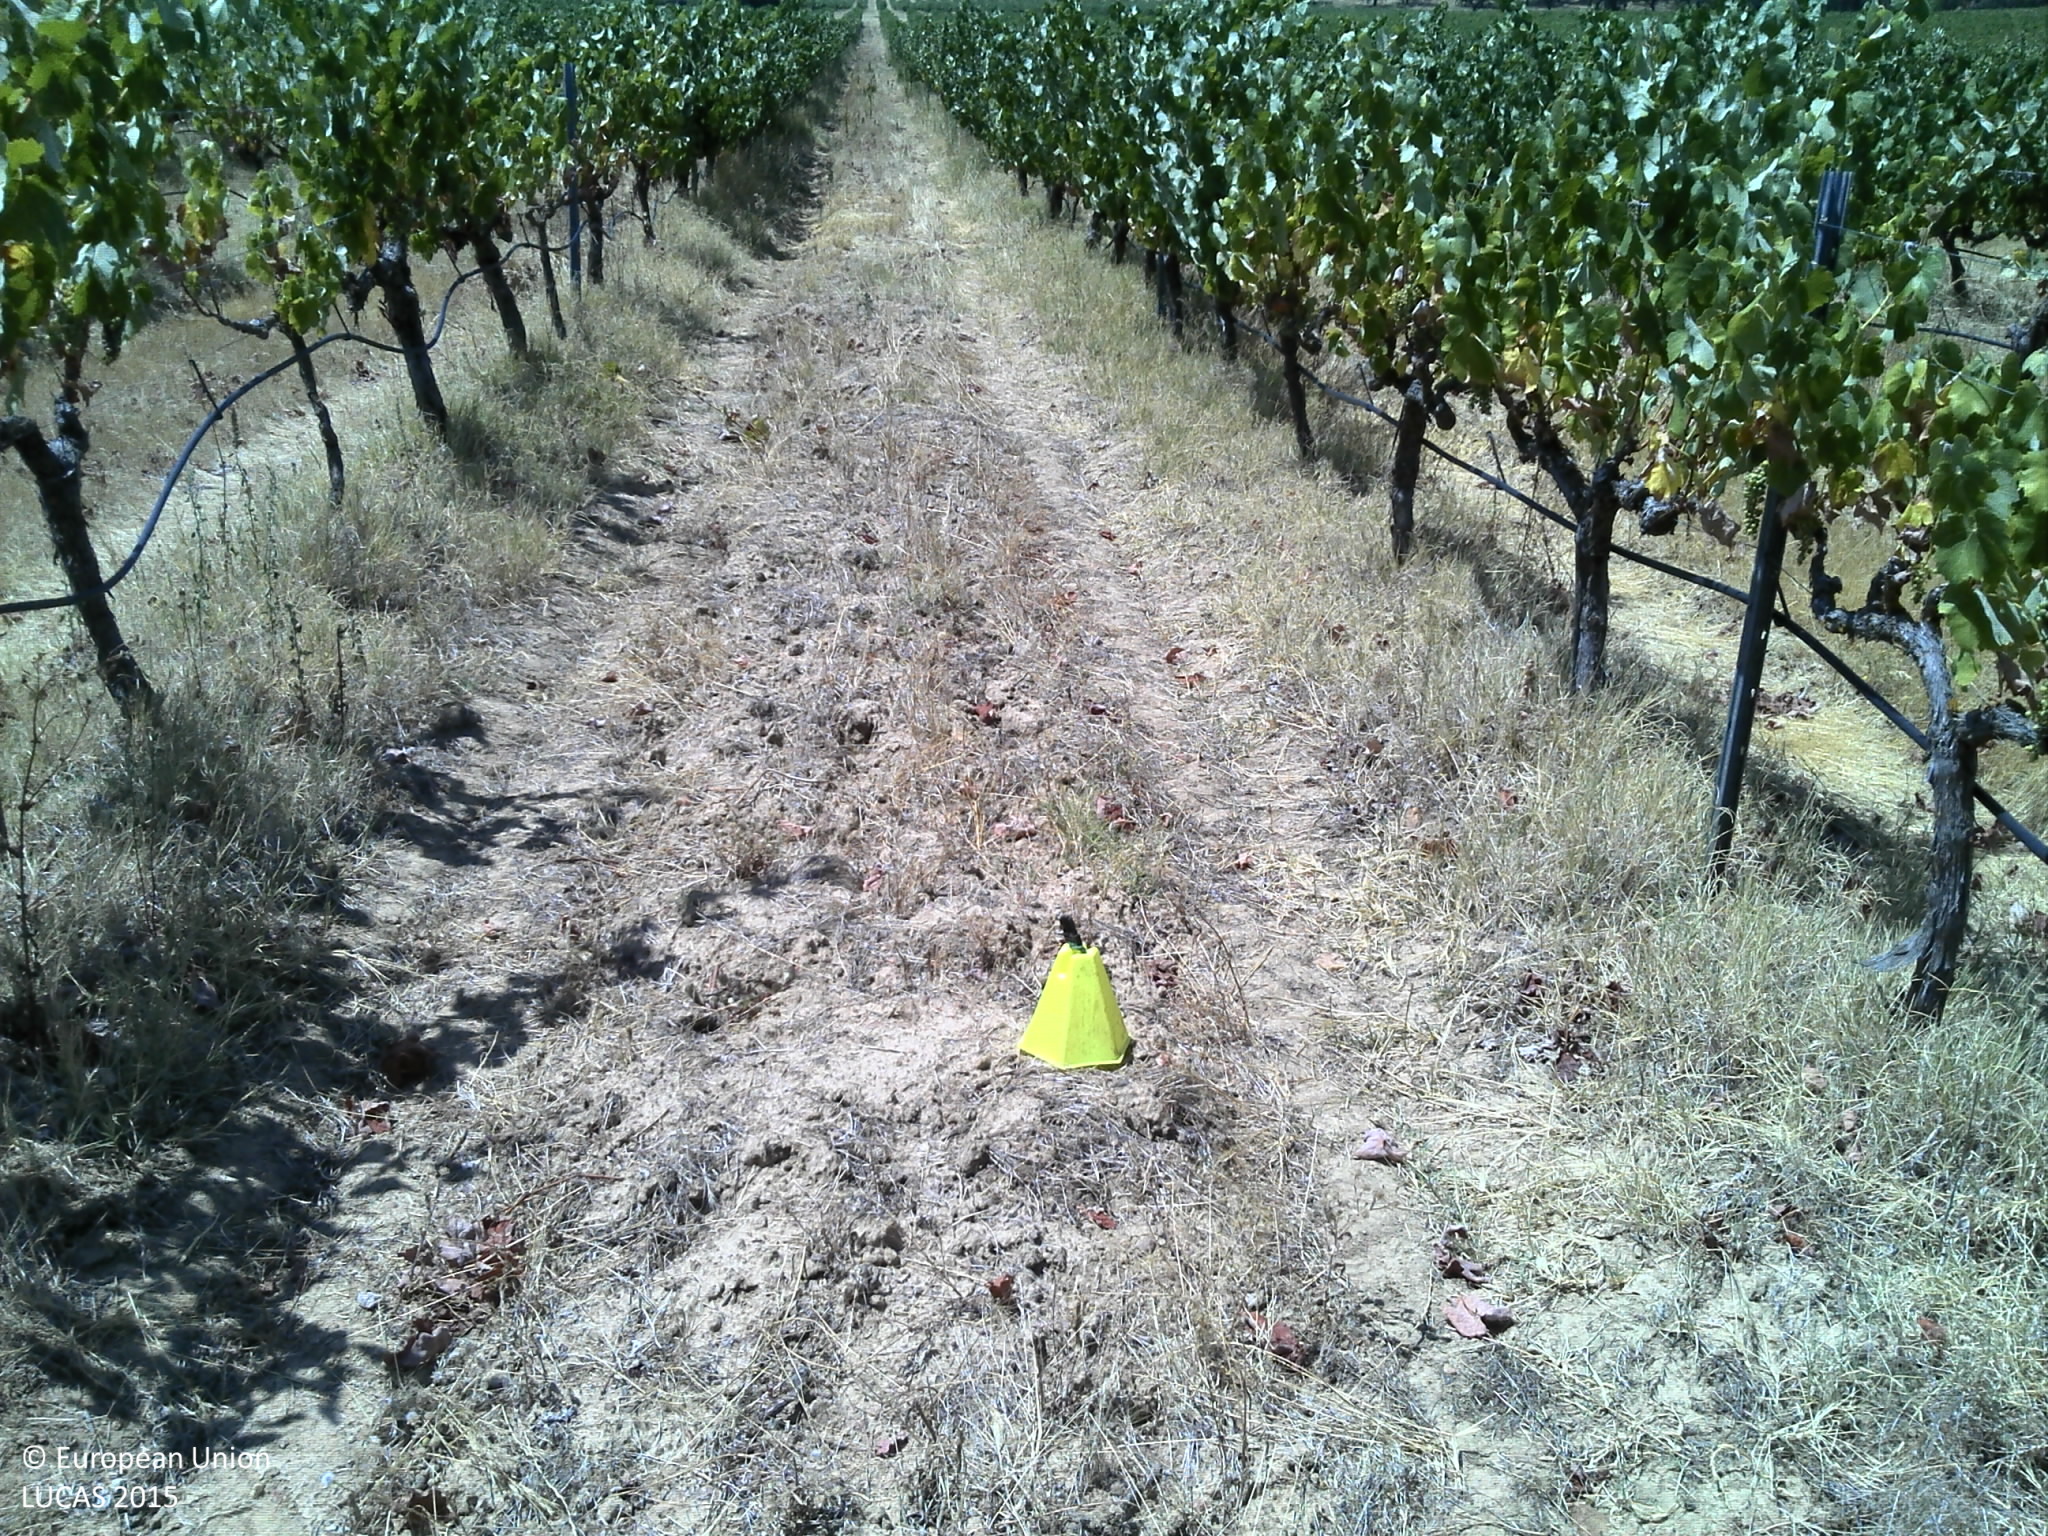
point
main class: Cropland
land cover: Vineyards
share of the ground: 25 - 50 %
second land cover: Other bare soil
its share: > 75 %
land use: Agriculture (excluding fallow land and kitchen gardens)
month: July
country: PT
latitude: 38.6911
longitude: -7.5428
